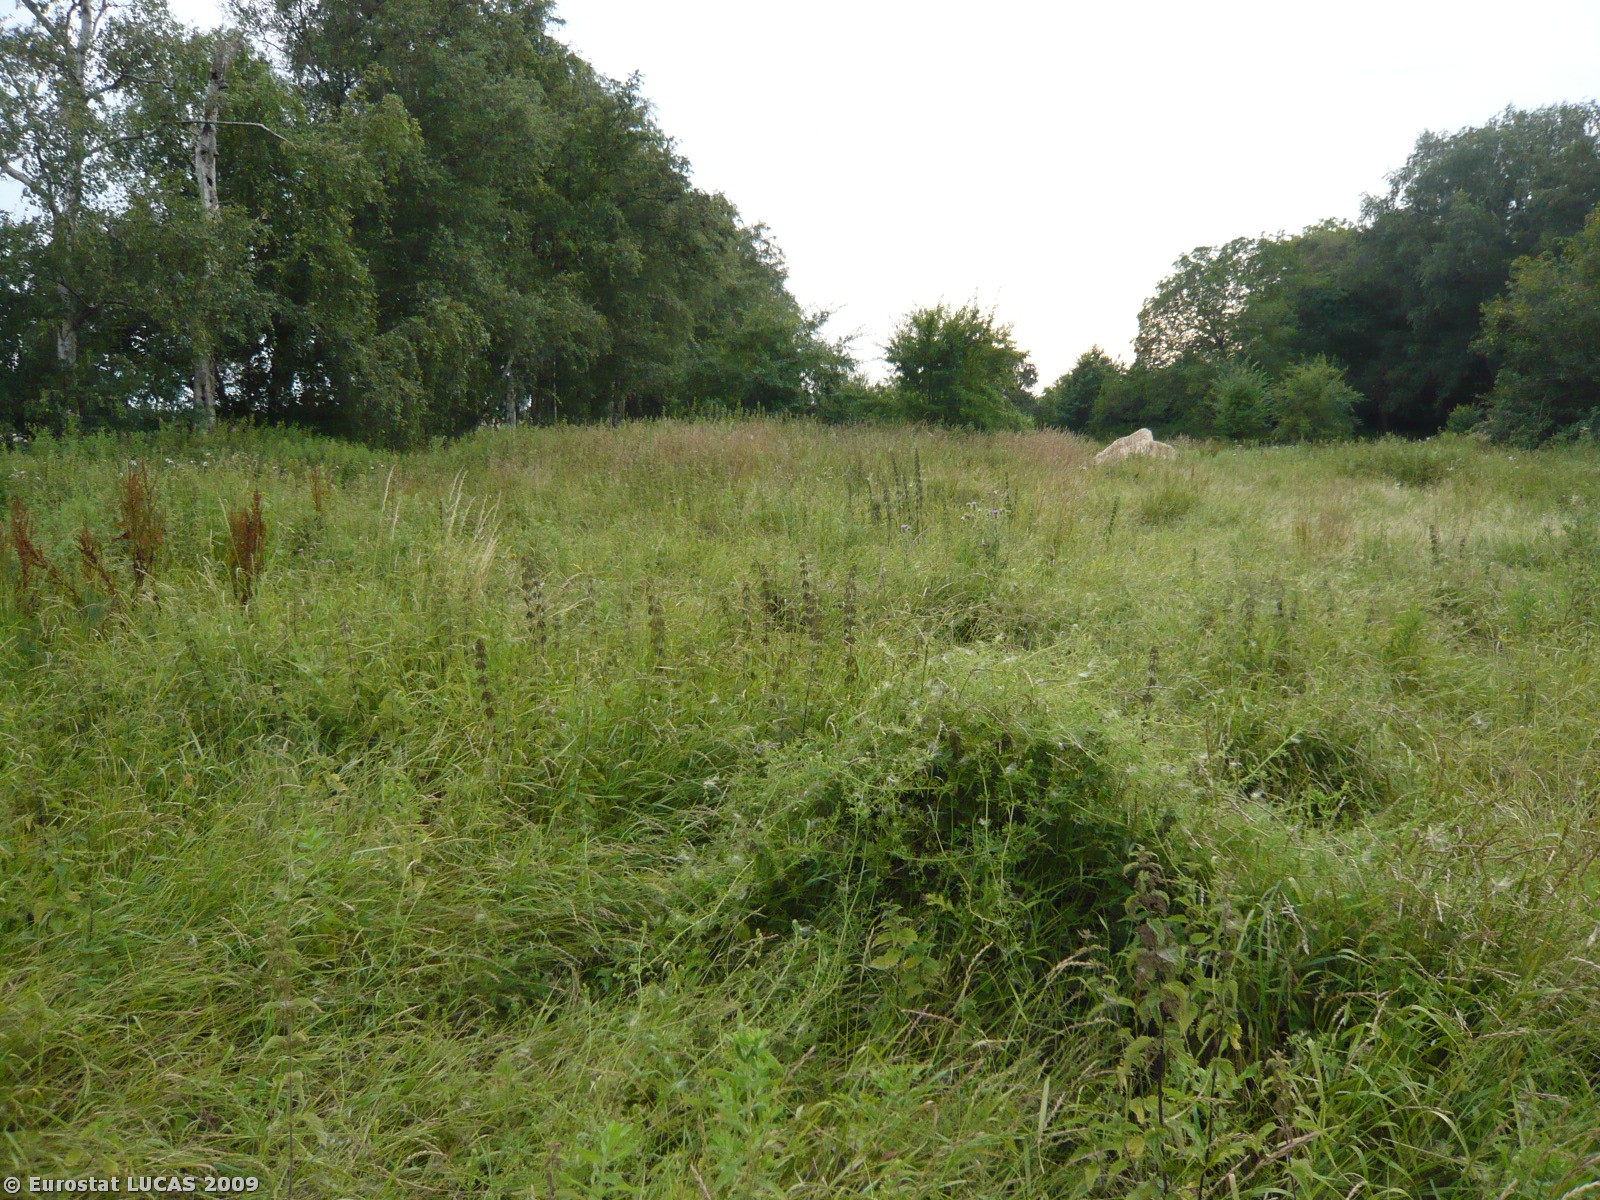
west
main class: Grassland
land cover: Spontaneously vegetated surfaces
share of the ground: > 75 %
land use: Residential
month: July
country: DK
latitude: 55.8994
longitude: 12.1890
